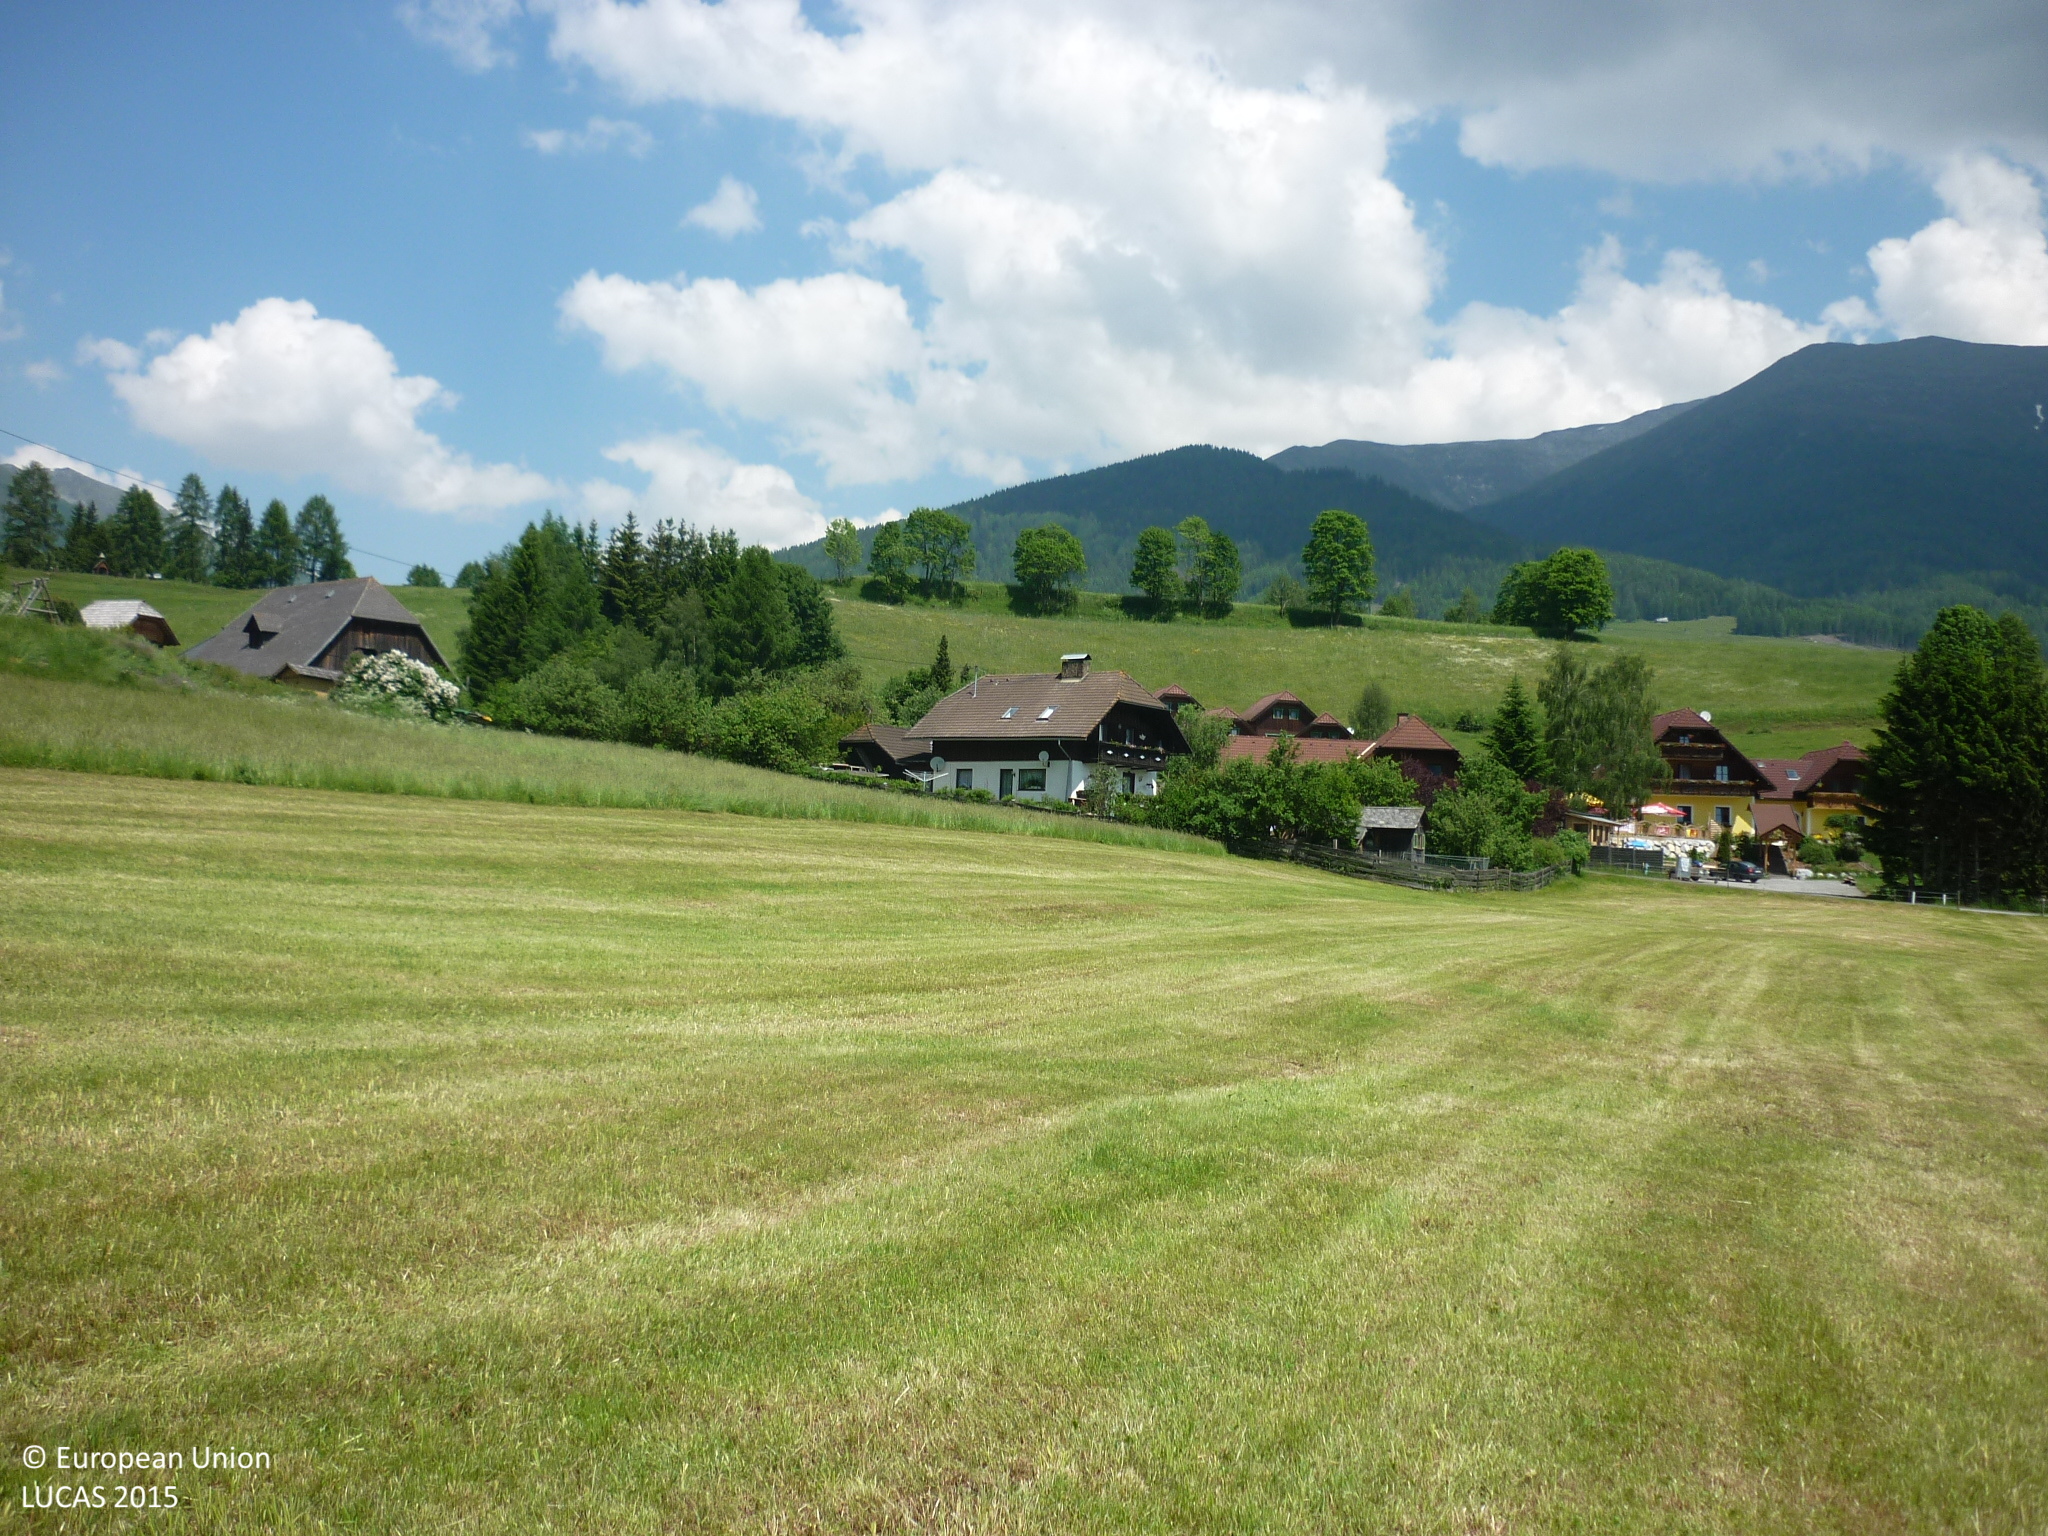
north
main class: Grassland
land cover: Grassland without tree/shrub cover
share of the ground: > 75 %
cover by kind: herbaceous plants 100 %
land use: Agriculture (excluding fallow land and kitchen gardens)
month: June
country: AT
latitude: 47.1780
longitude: 13.9962
